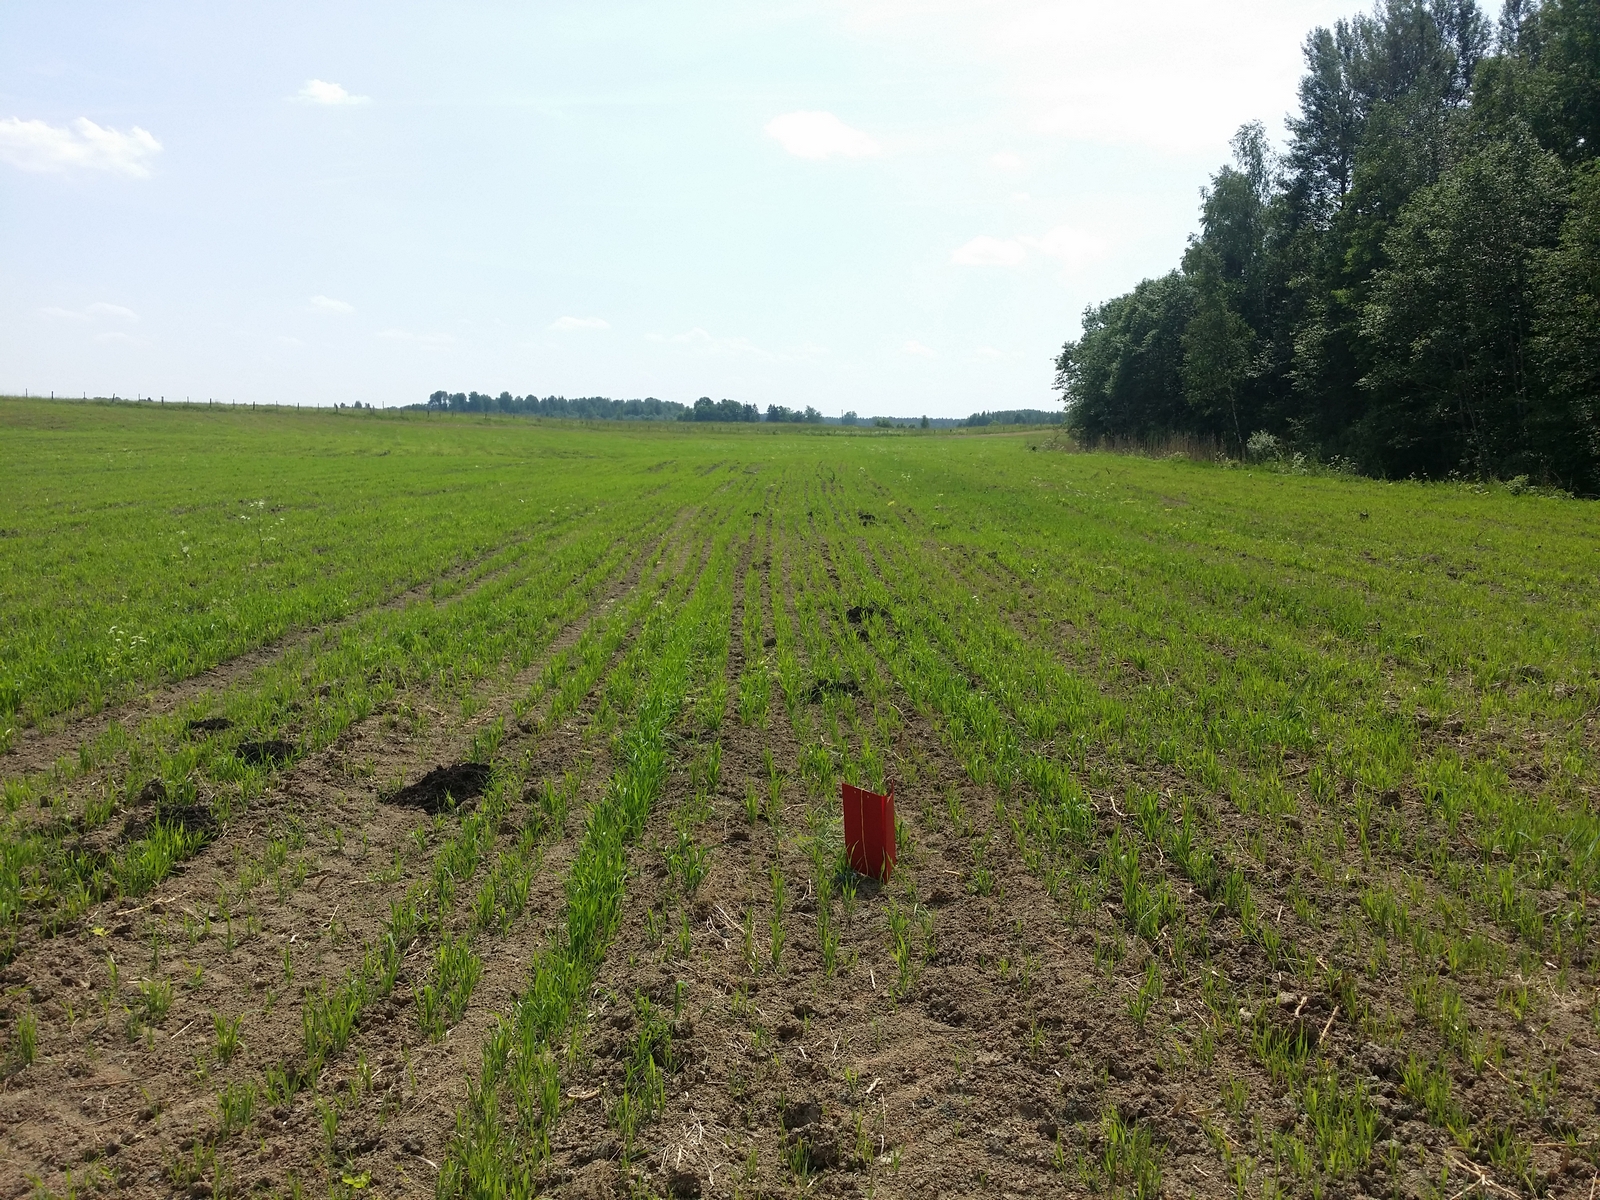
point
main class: Cropland
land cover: Oats
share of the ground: 10 - 25 %
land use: Agriculture (excluding fallow land and kitchen gardens)
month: June
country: LV
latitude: 57.4437
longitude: 26.5219
